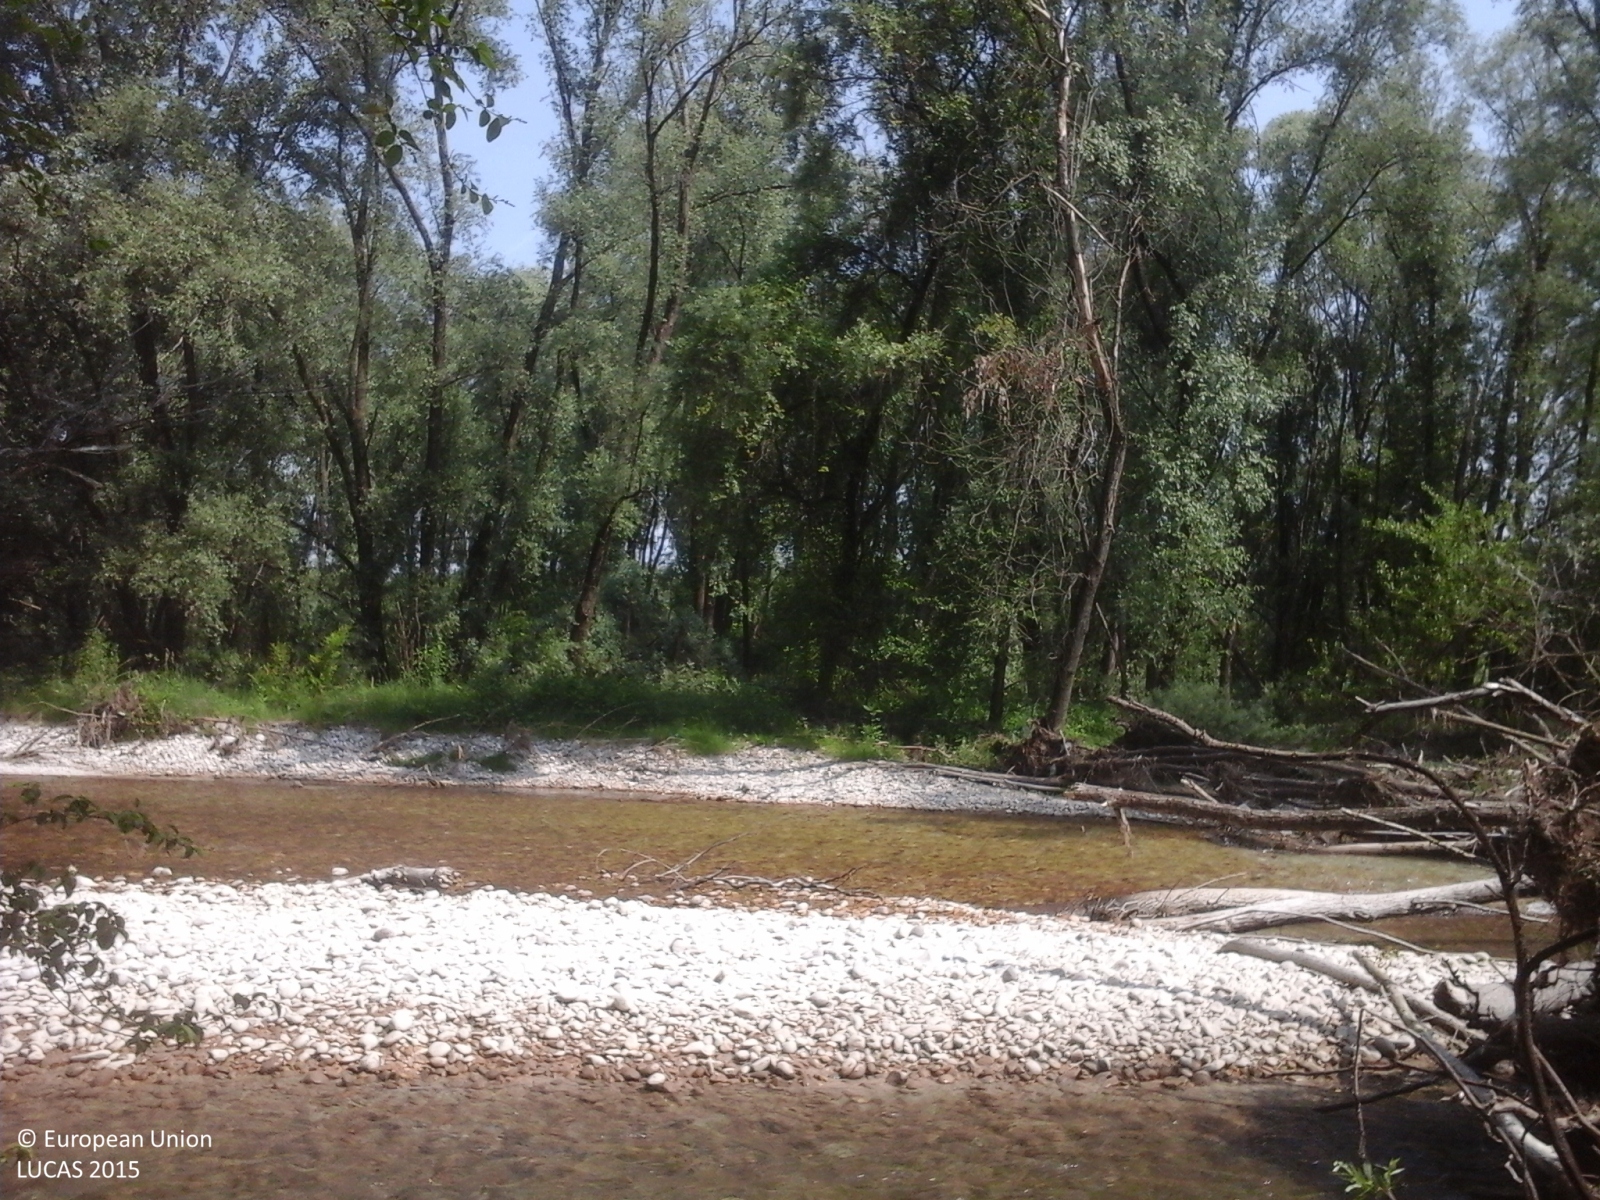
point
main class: Woodland
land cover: Broadleaved woodland
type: thermophilous deciduous forest
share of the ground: > 75 %
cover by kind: broadleaved forest trees 100 %
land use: Semi-natural and natural areas not in use
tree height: > 5 m
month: May
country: IT
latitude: 45.6345
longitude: 11.7291
